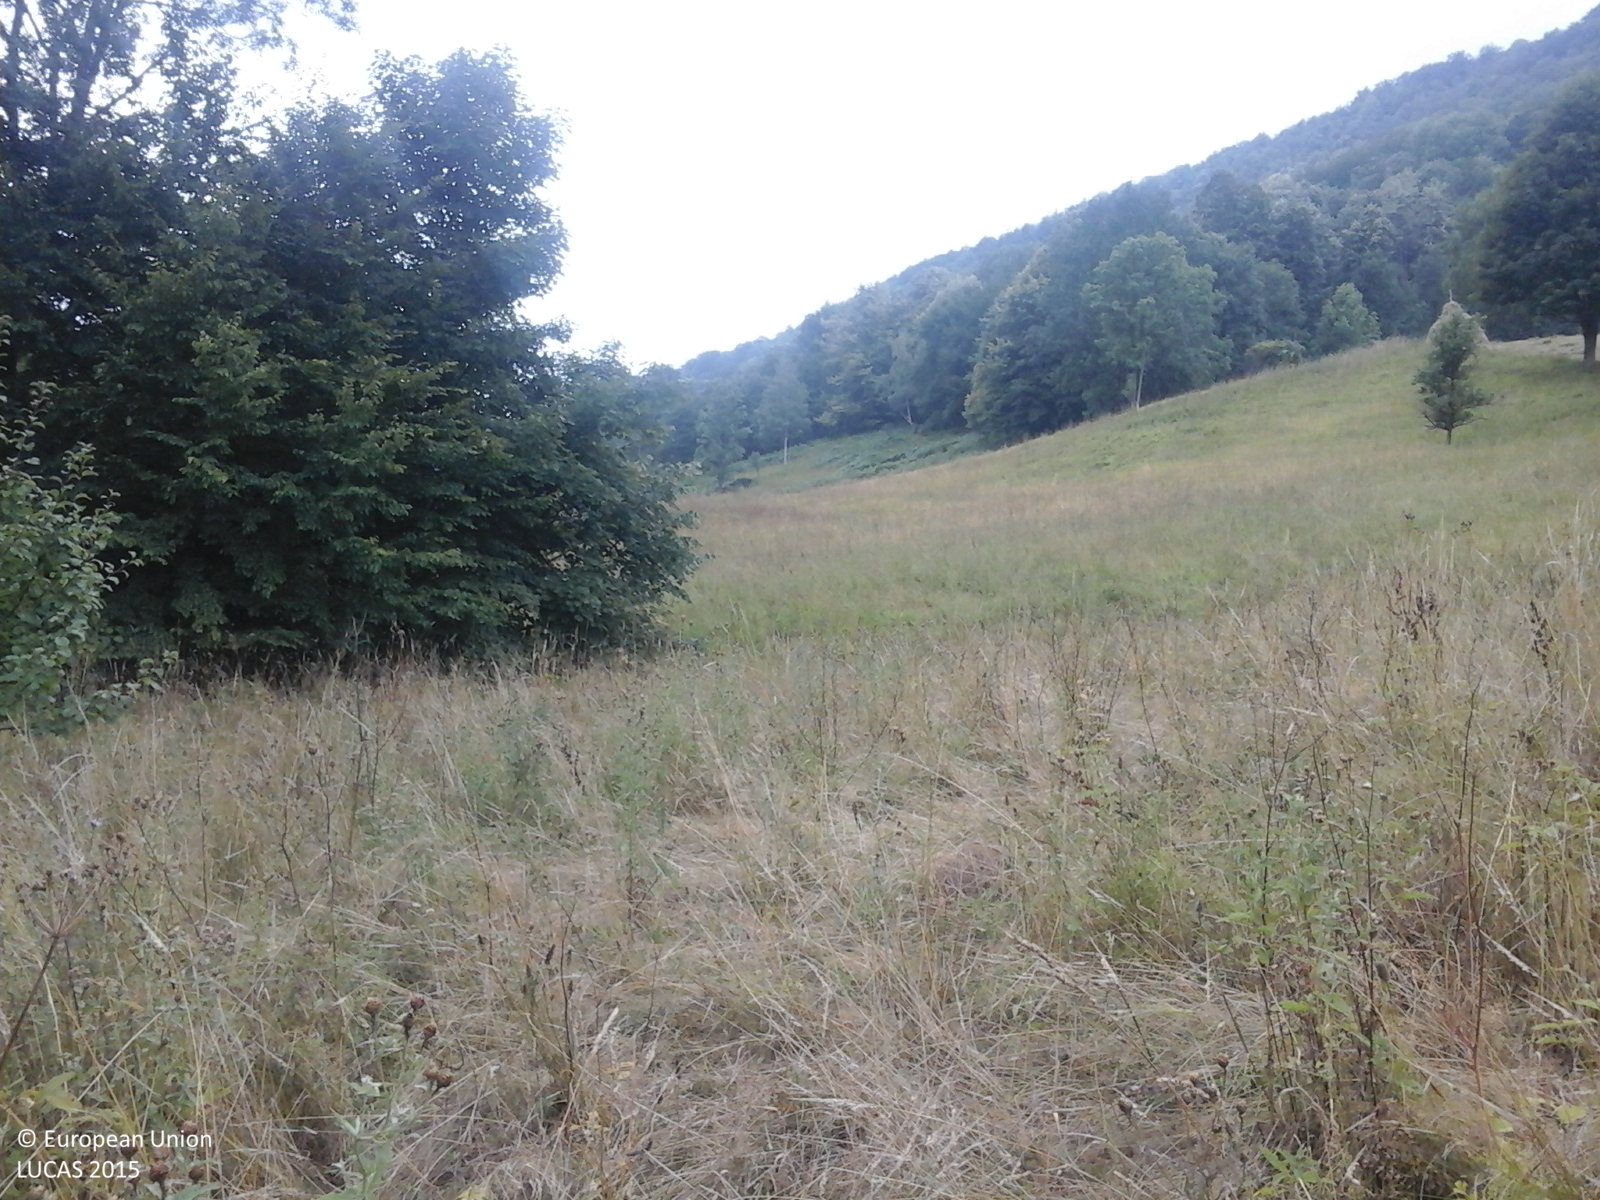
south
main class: Grassland
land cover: Grassland without tree/shrub cover
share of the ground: > 75 %
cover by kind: herbaceous plants 100 %
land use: Agriculture (excluding fallow land and kitchen gardens)
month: August
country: RO
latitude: 45.2420
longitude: 21.9477
